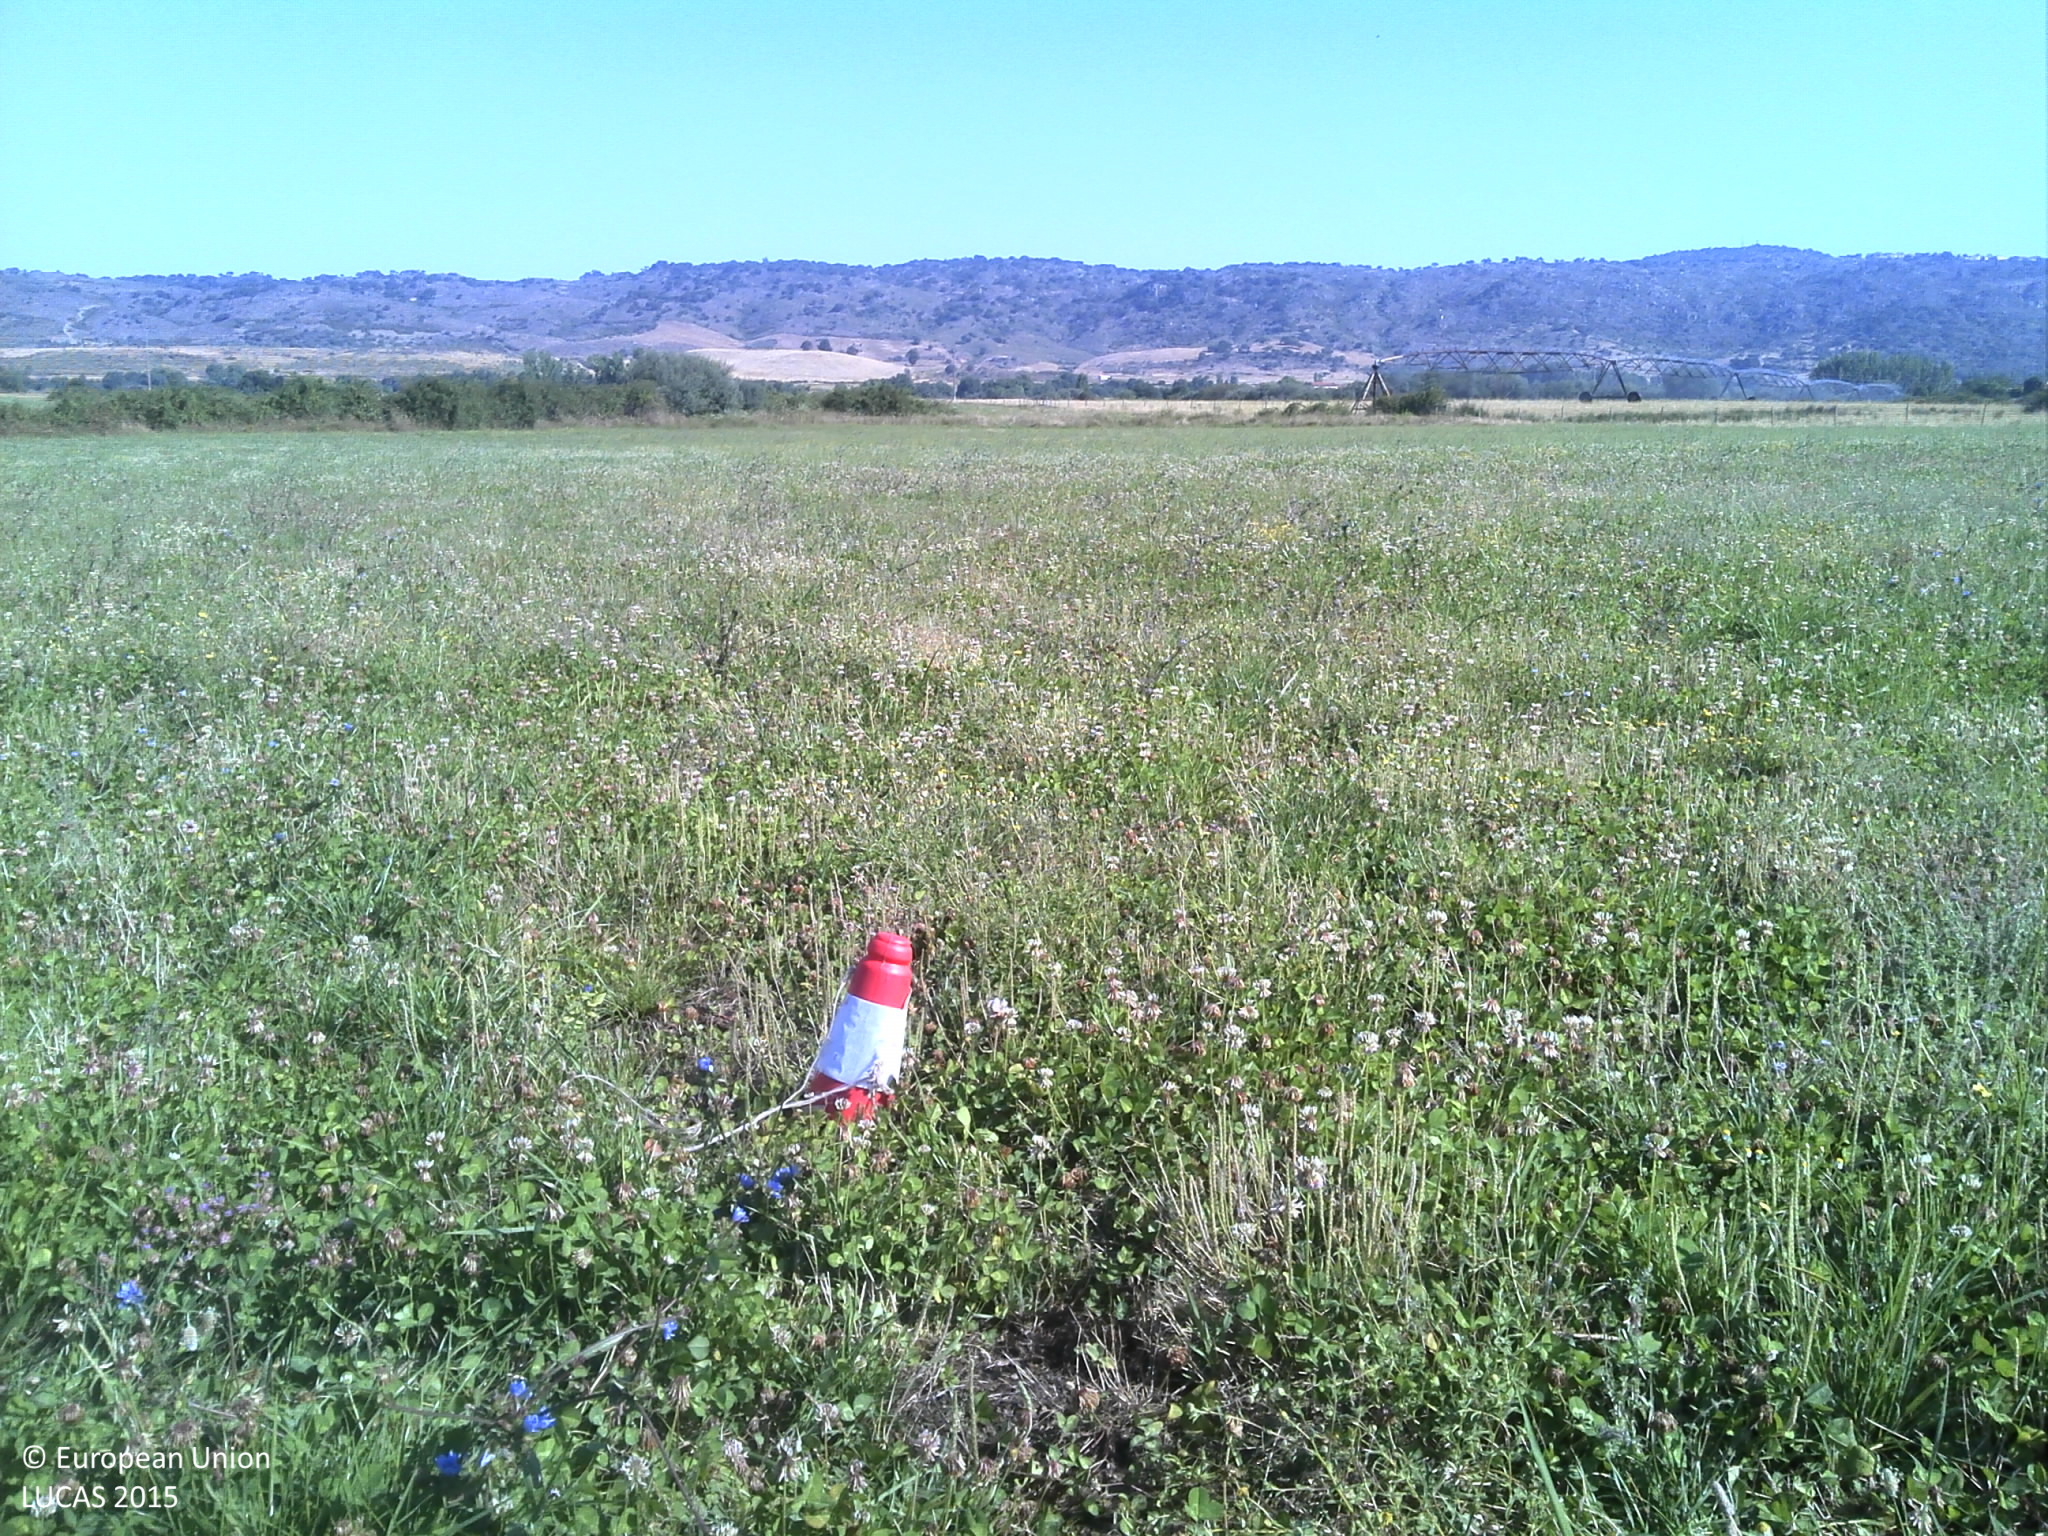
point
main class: Cropland
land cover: Temporary grasslands
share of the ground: > 75 %
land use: Agriculture (excluding fallow land and kitchen gardens)
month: June
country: PT
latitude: 39.8887
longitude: -7.2499
